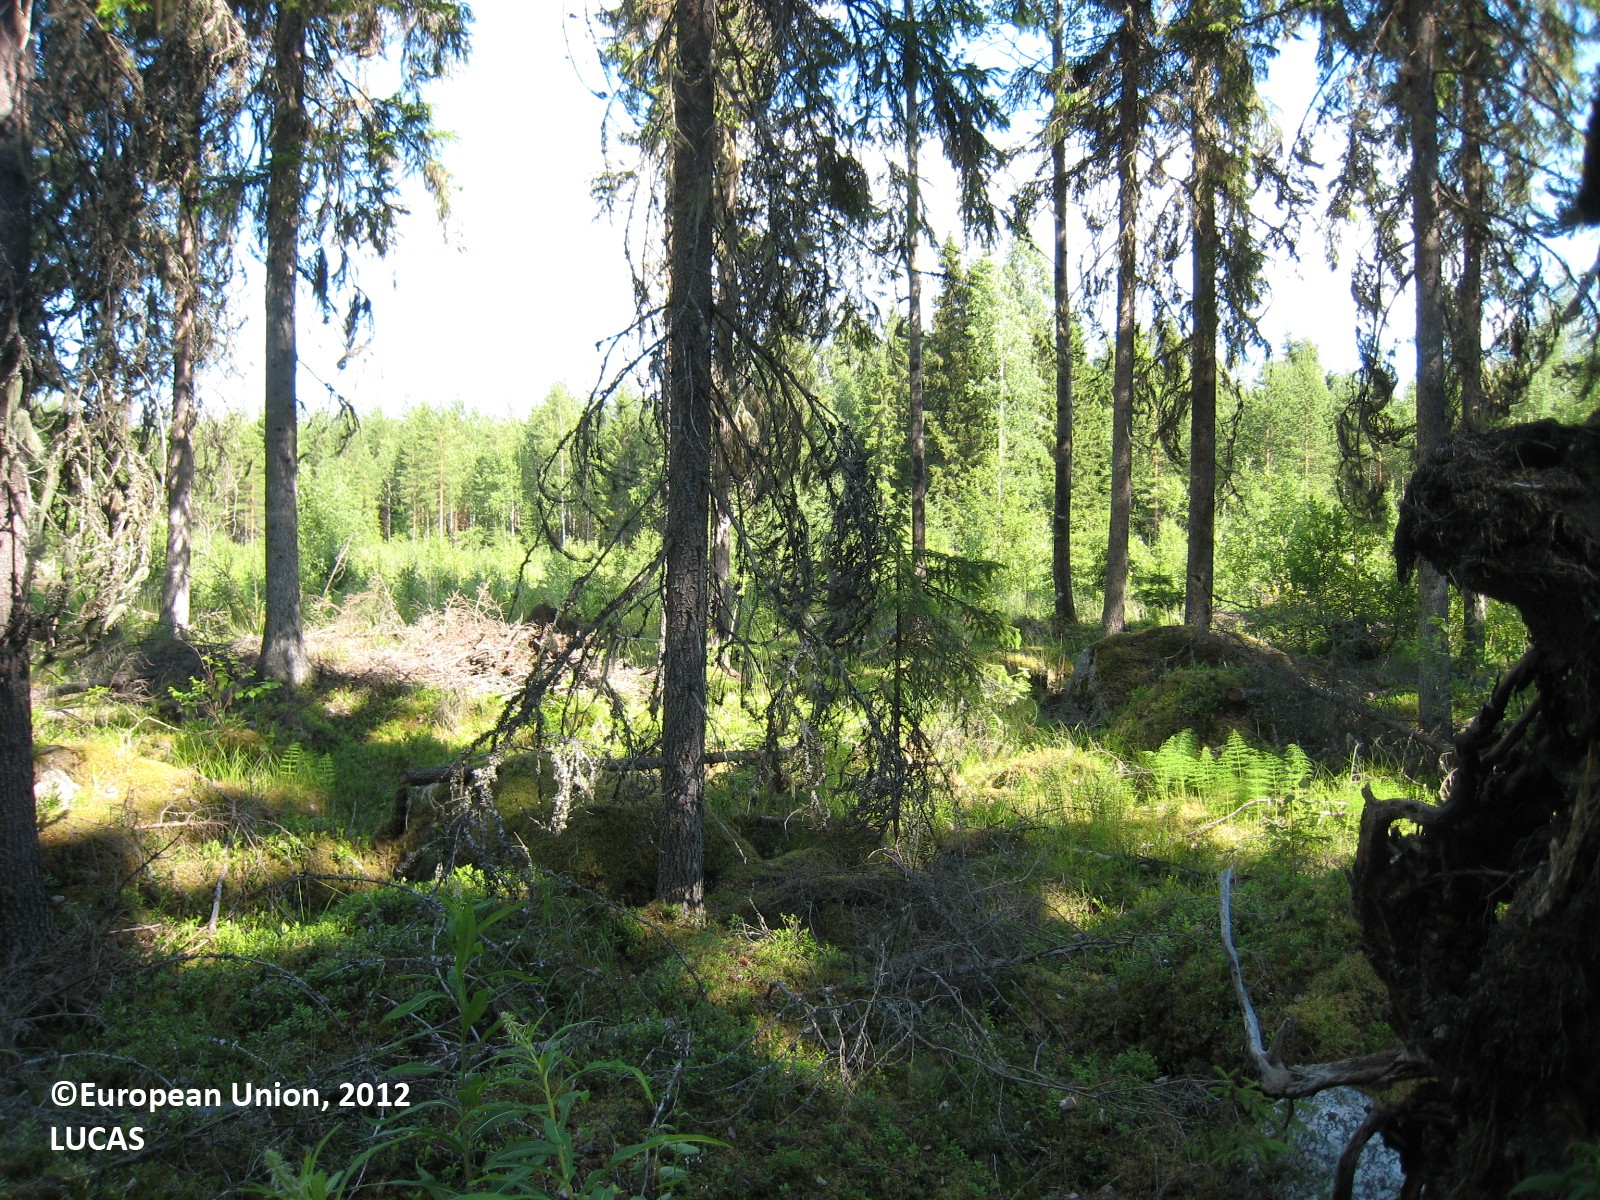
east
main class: Woodland
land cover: Spruce dominated coniferous woodland
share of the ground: 25 - 50 %
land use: Forestry
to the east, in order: Spruce dominated coniferous woodland; Spruce dominated mixed woodland; Broadleaved woodland; Ditches and canals; Broadleaved woodland; Other mixed woodland; Other coniferous woodland; Other mixed woodland; Spruce dominated coniferous woodland; Spruce dominated mixed woodland; Ditches and canals; Spruce dominated mixed woodland
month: July
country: FI
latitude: 62.6036
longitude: 26.1194
